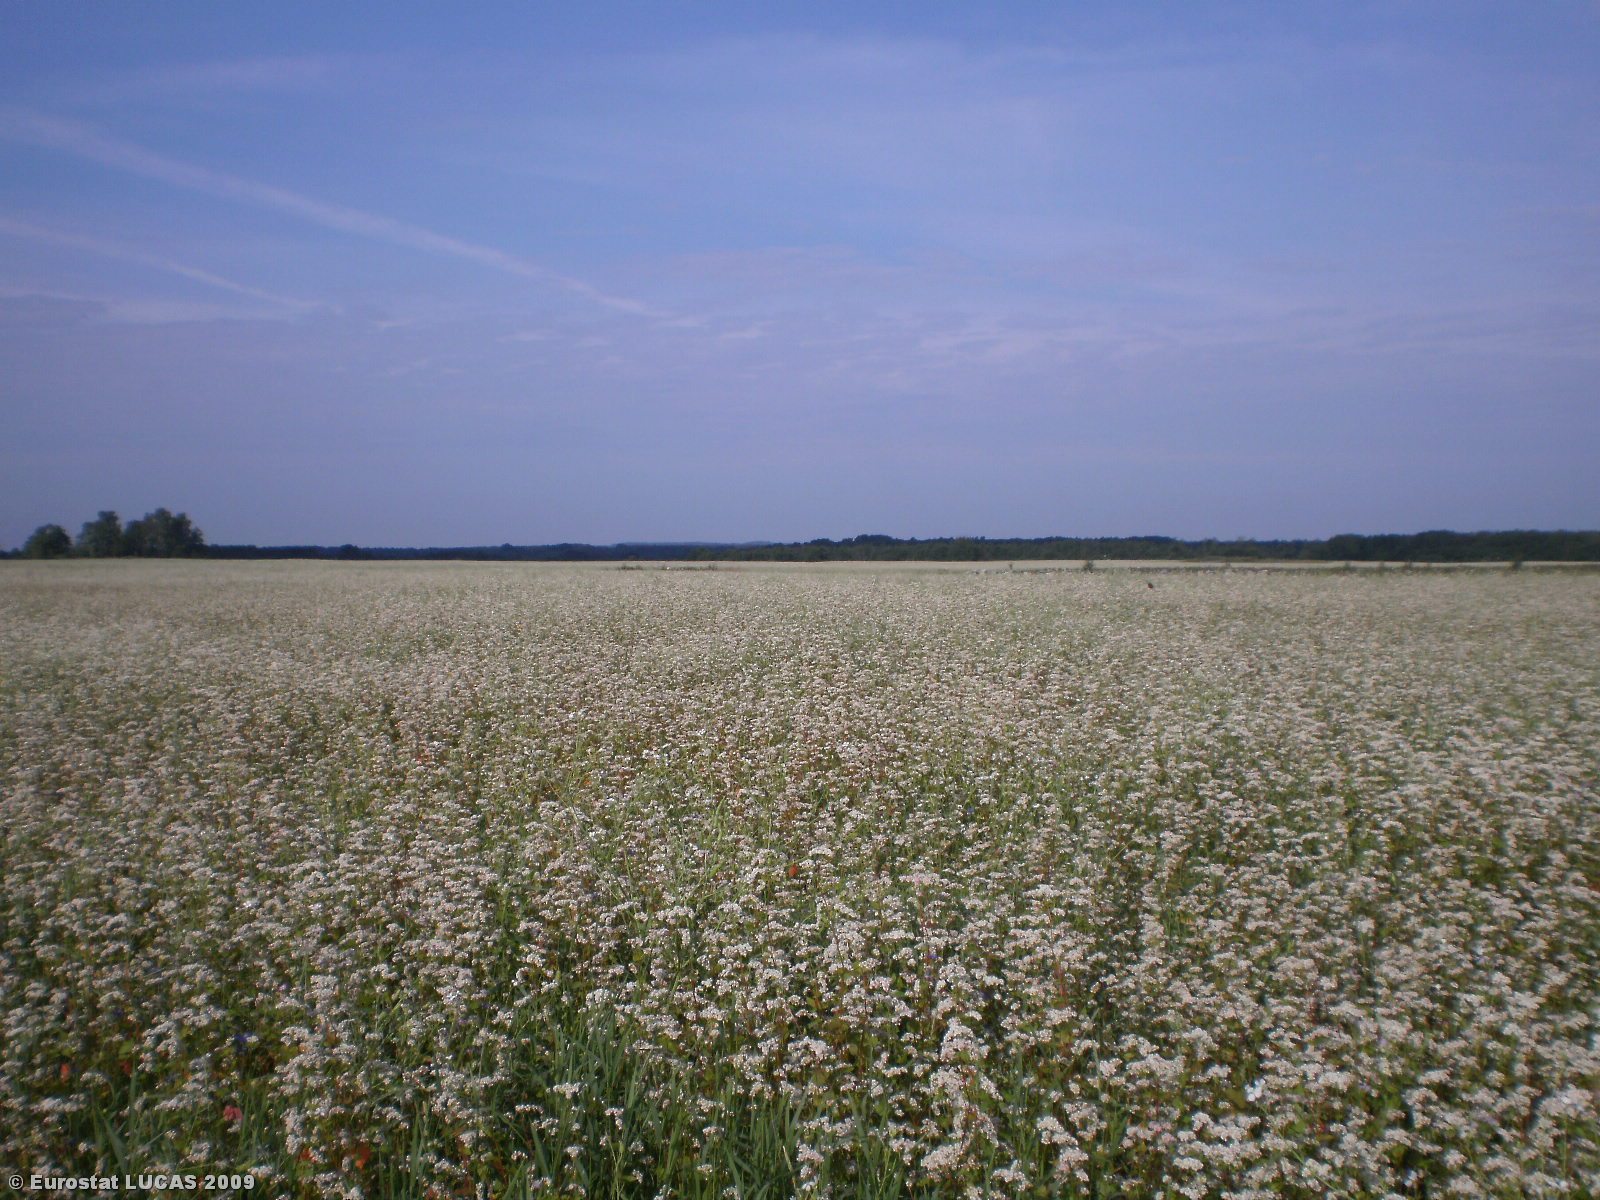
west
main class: Cropland
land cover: Other cereals
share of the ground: > 75 %
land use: Agriculture (excluding fallow land and kitchen gardens)
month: July
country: LT
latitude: 55.8466
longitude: 25.7661
